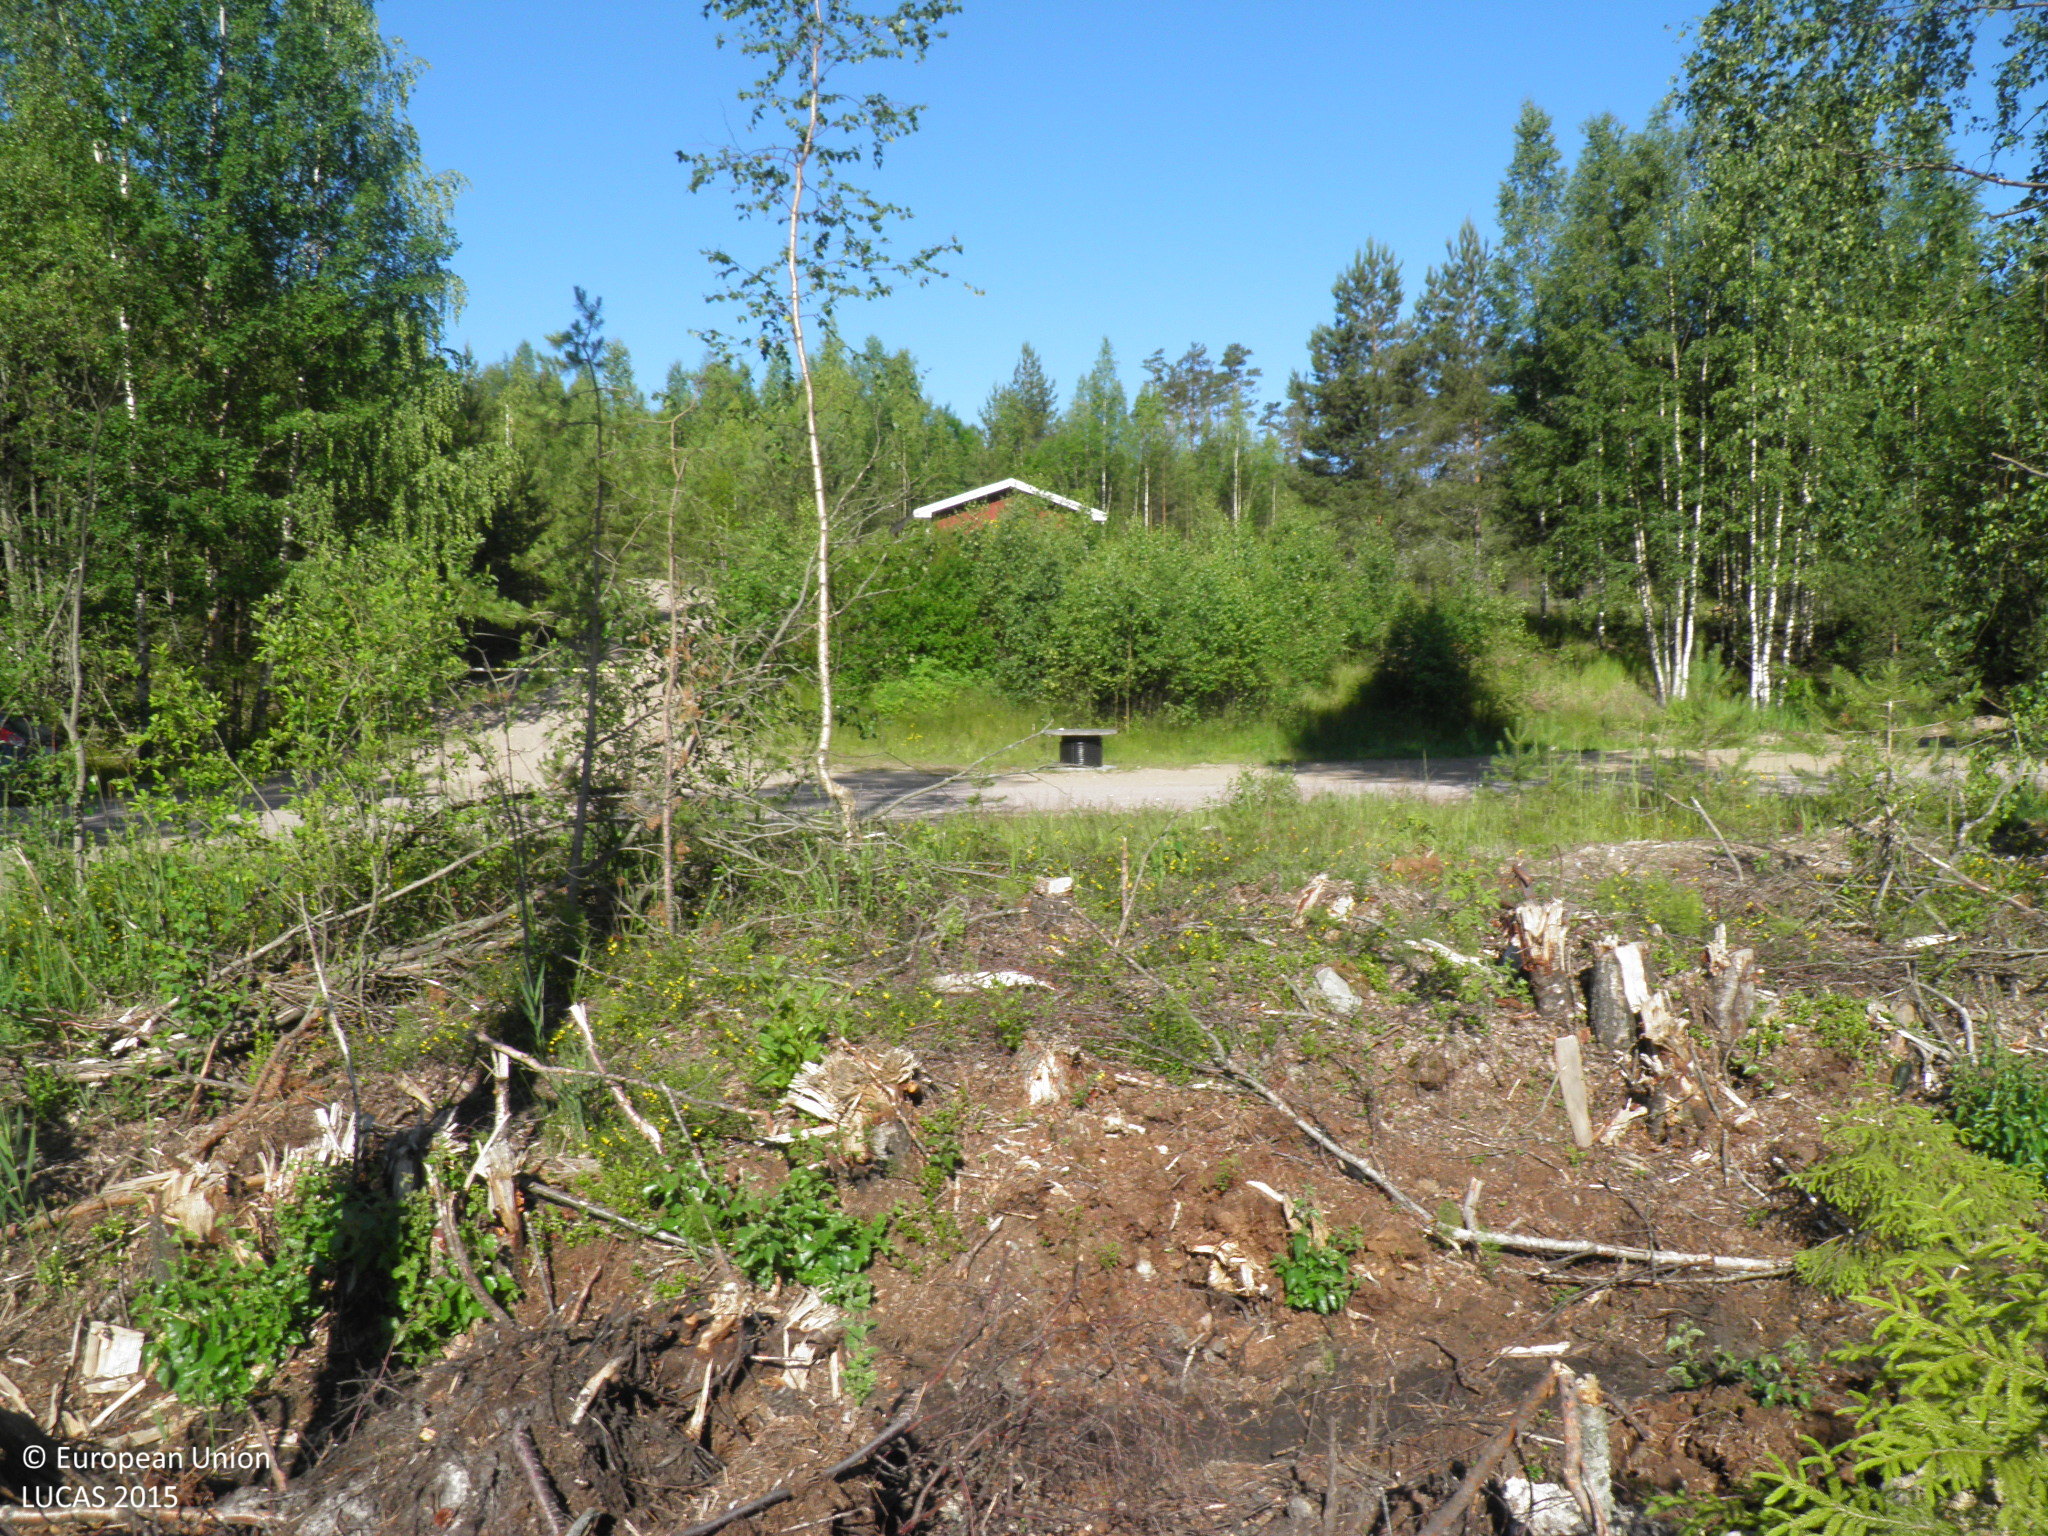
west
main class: Grassland
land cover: Spontaneously vegetated surfaces
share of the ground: 10 - 25 %
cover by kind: unconsolidated bare surface 80 %, herbaceous plants 15 %, shrubs 5 %
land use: Forestry
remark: Clear cut
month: July
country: FI
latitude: 60.5465
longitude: 22.7817
